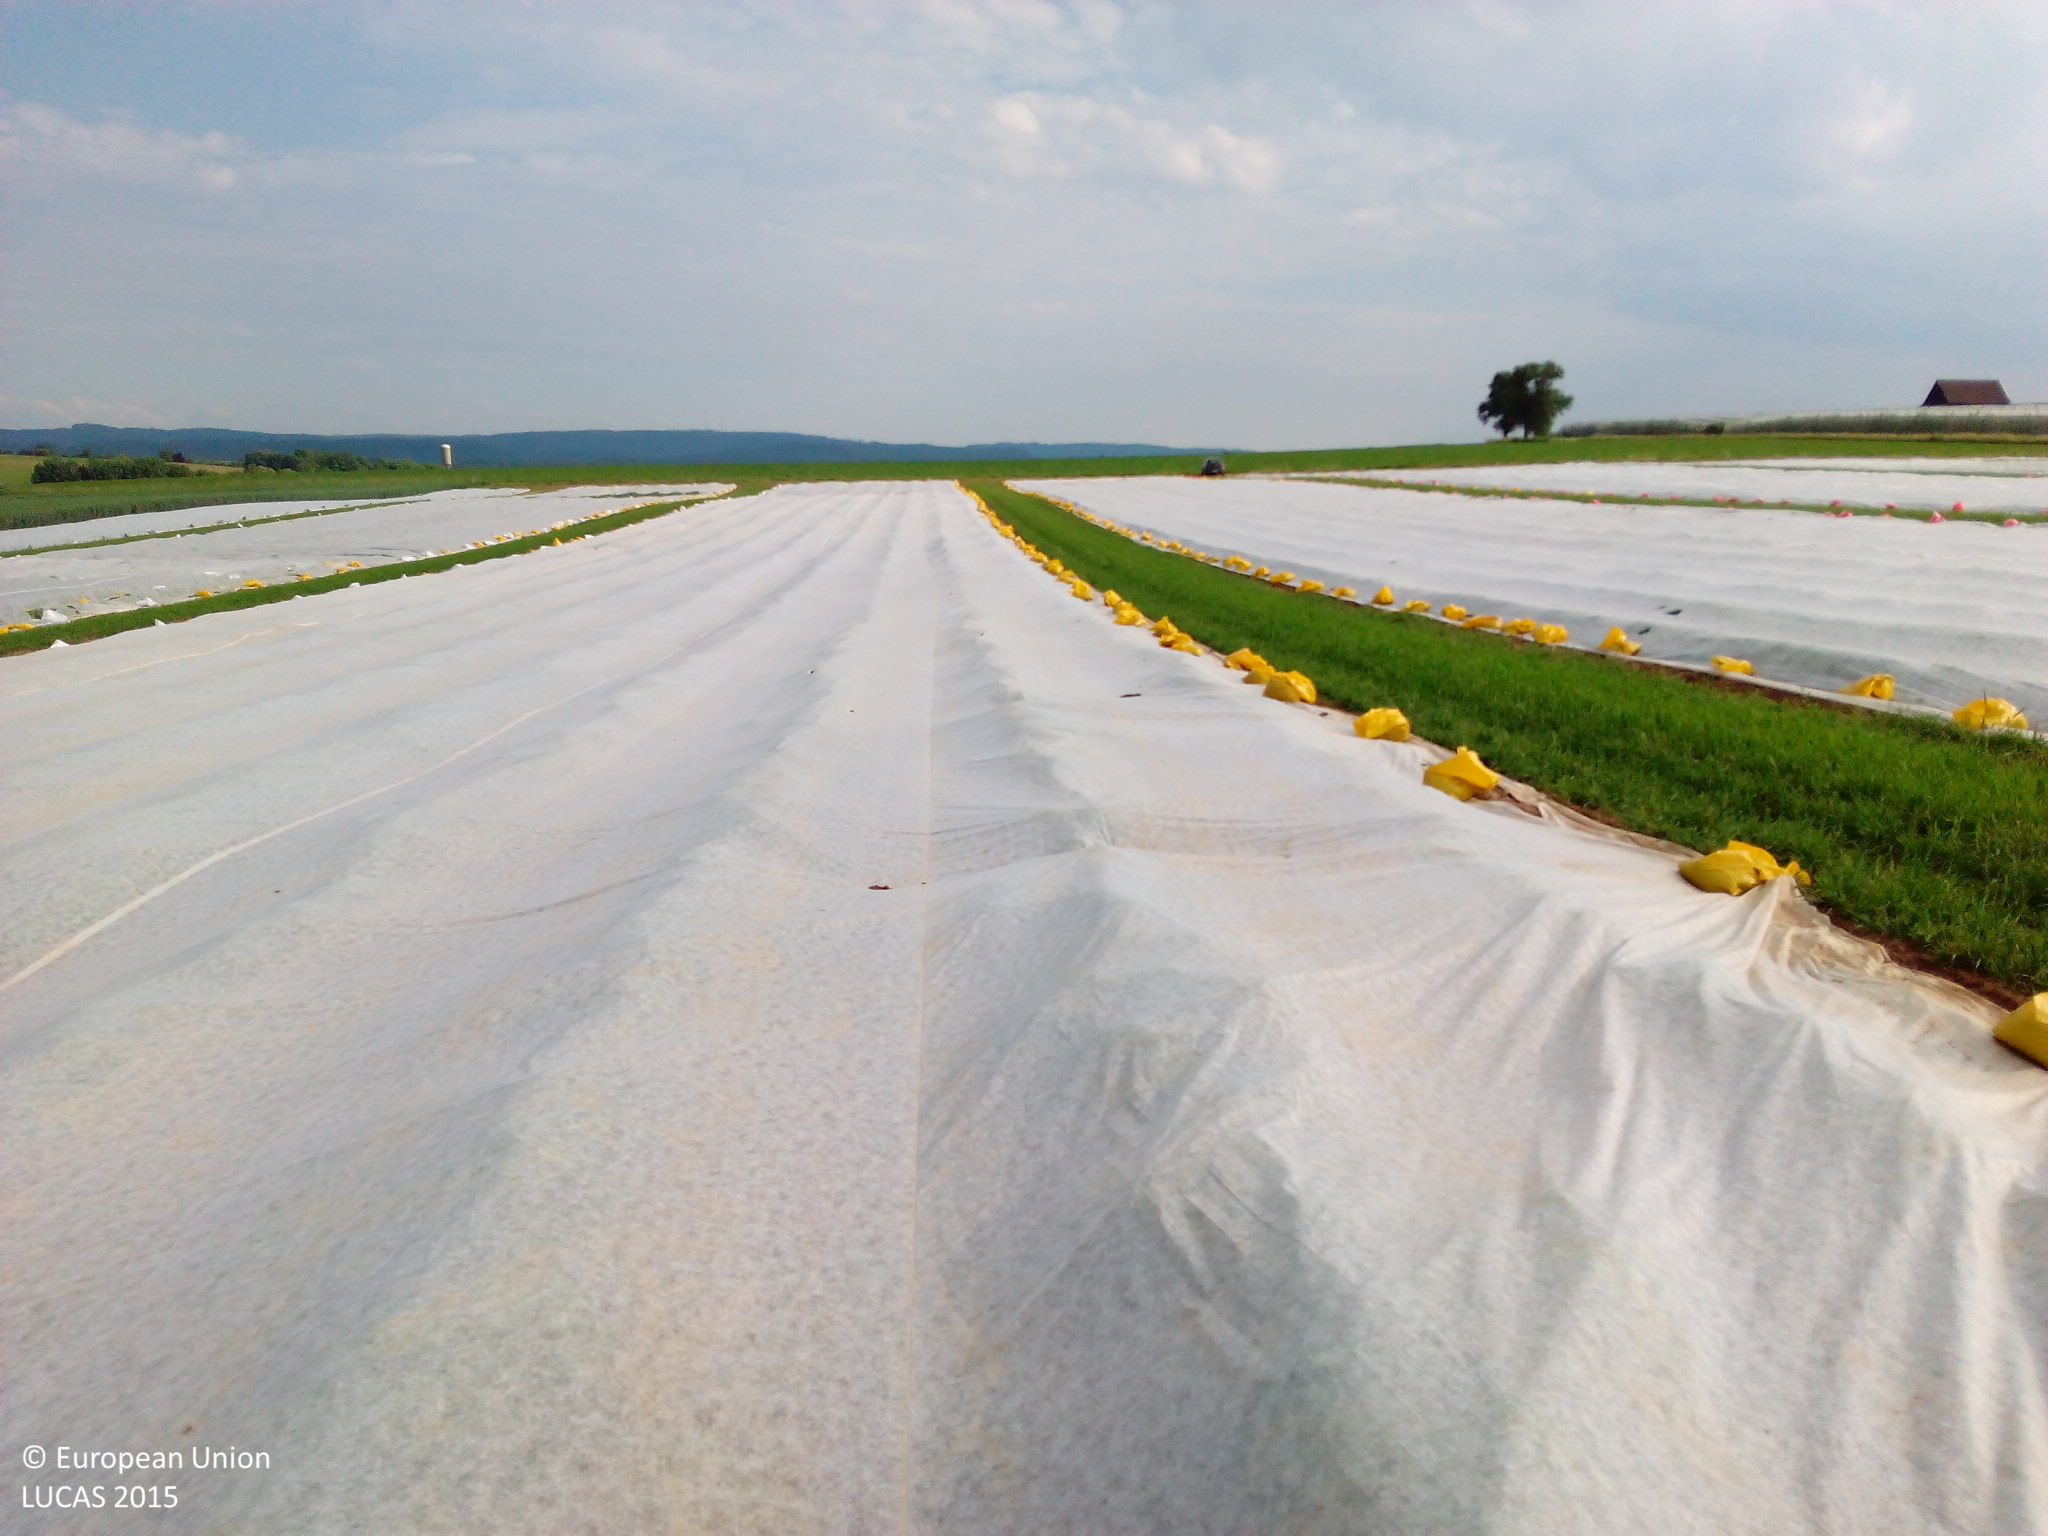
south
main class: Cropland
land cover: Other fresh vegetables
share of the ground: 10 - 25 %
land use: Agriculture (excluding fallow land and kitchen gardens)
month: May
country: DE
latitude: 49.1935
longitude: 9.4102
